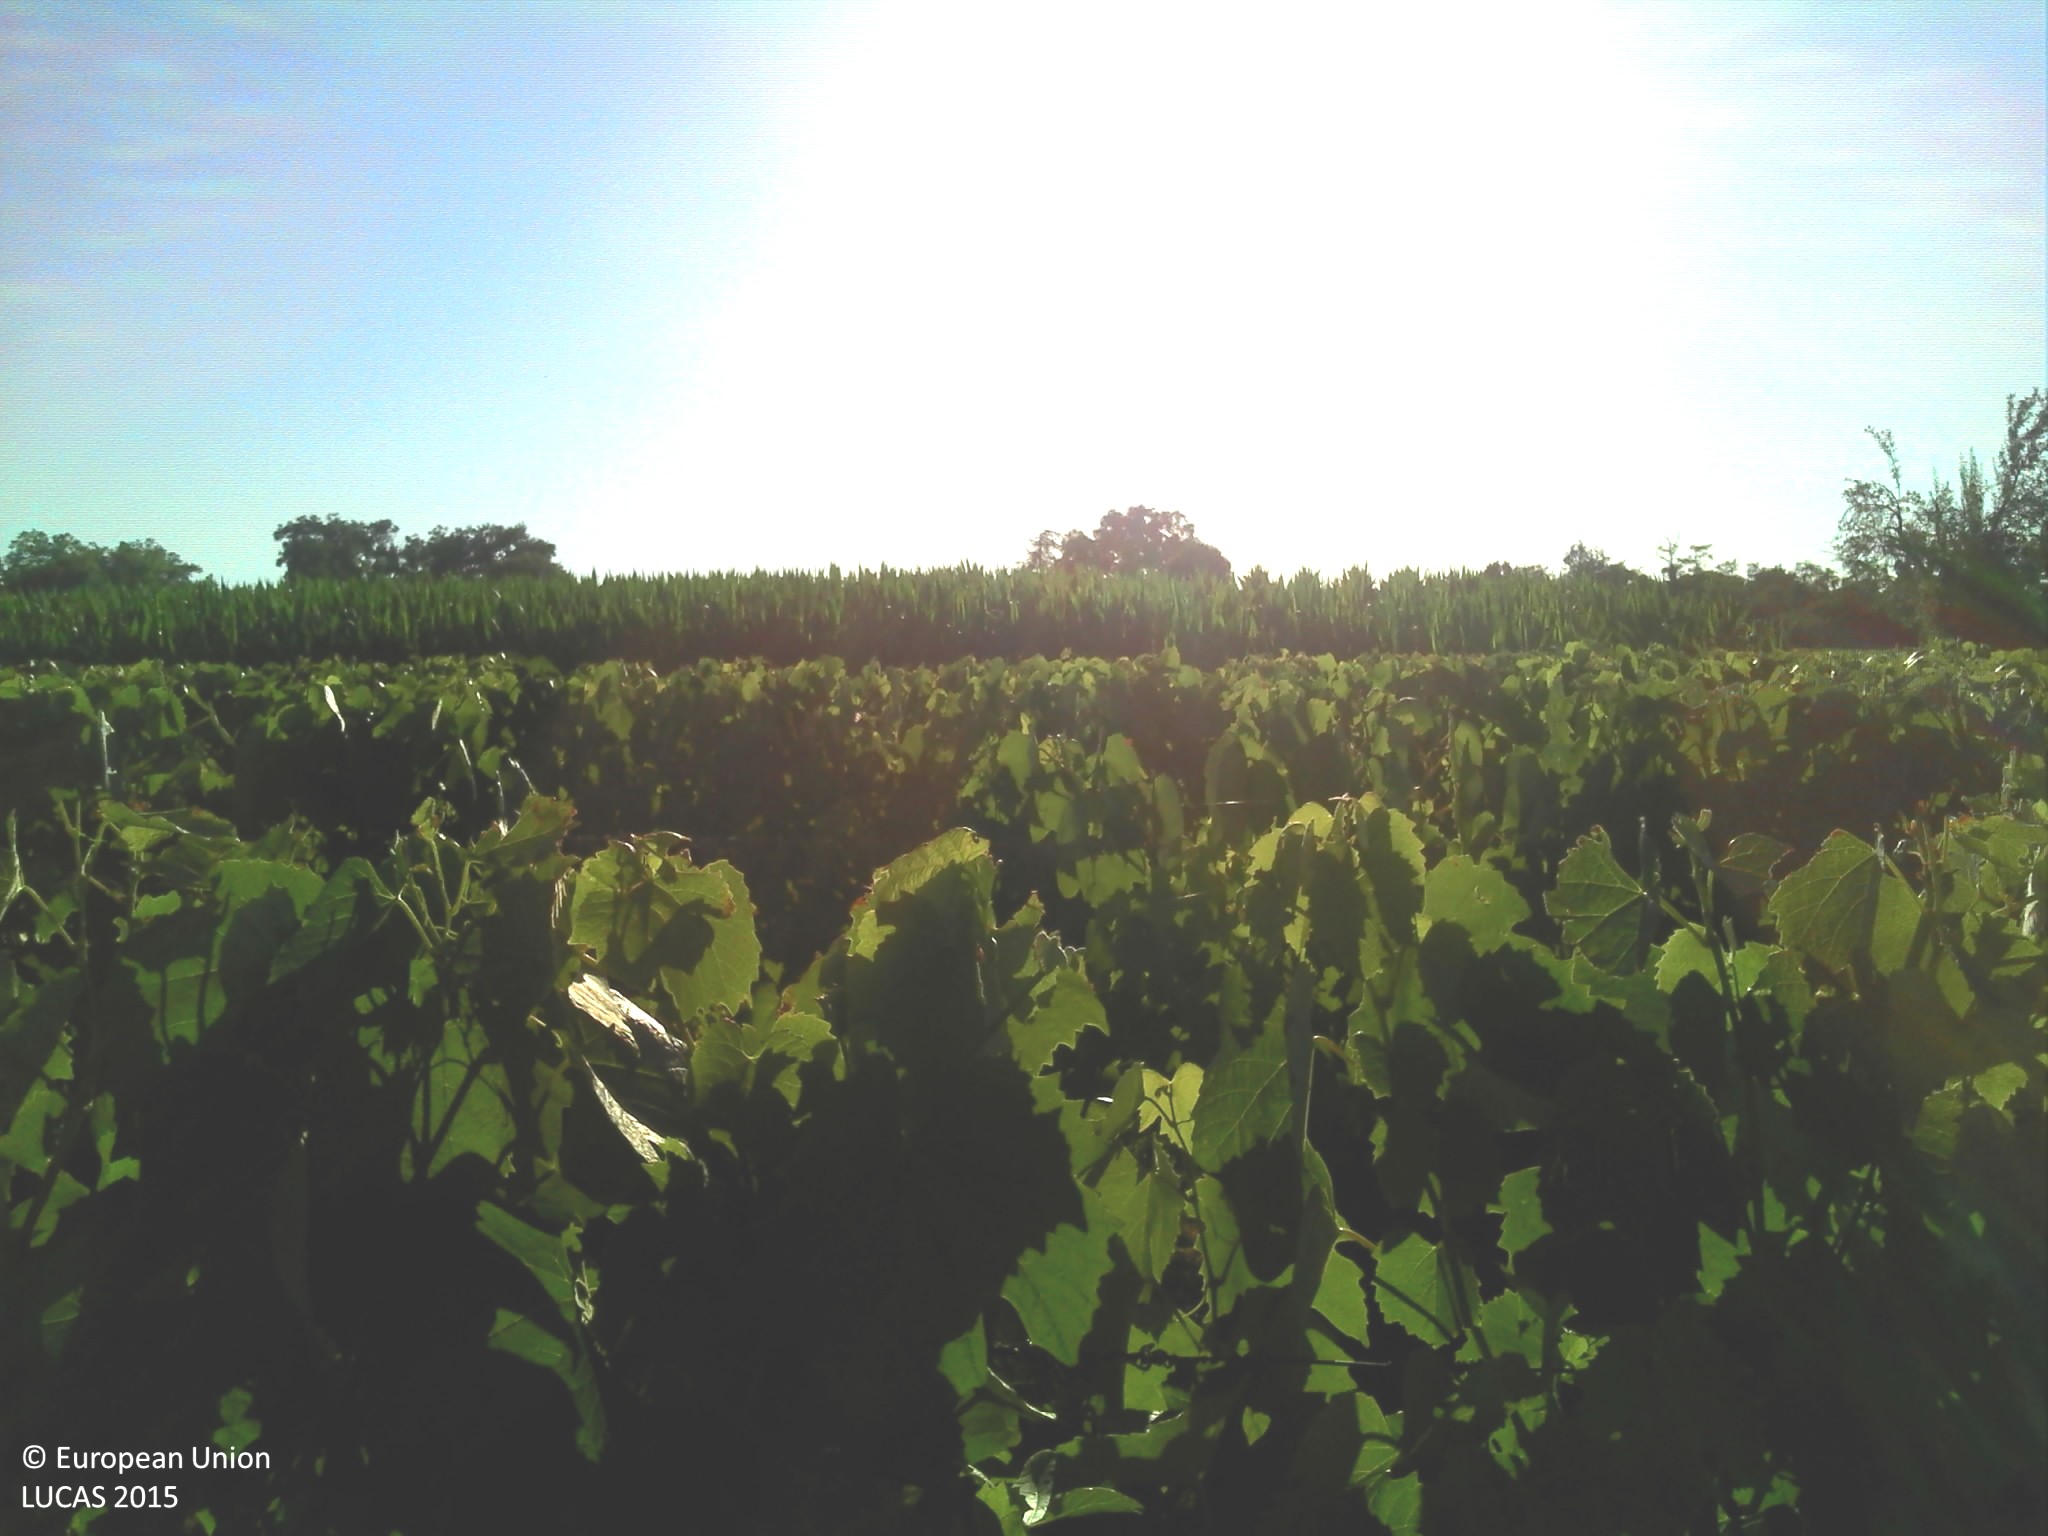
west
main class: Cropland
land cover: Vineyards
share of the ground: 25 - 50 %
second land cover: Grassland without tree/shrub cover
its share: 25 - 50 %
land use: Agriculture (excluding fallow land and kitchen gardens)
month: July
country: FR
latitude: 43.8957
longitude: -0.2555
